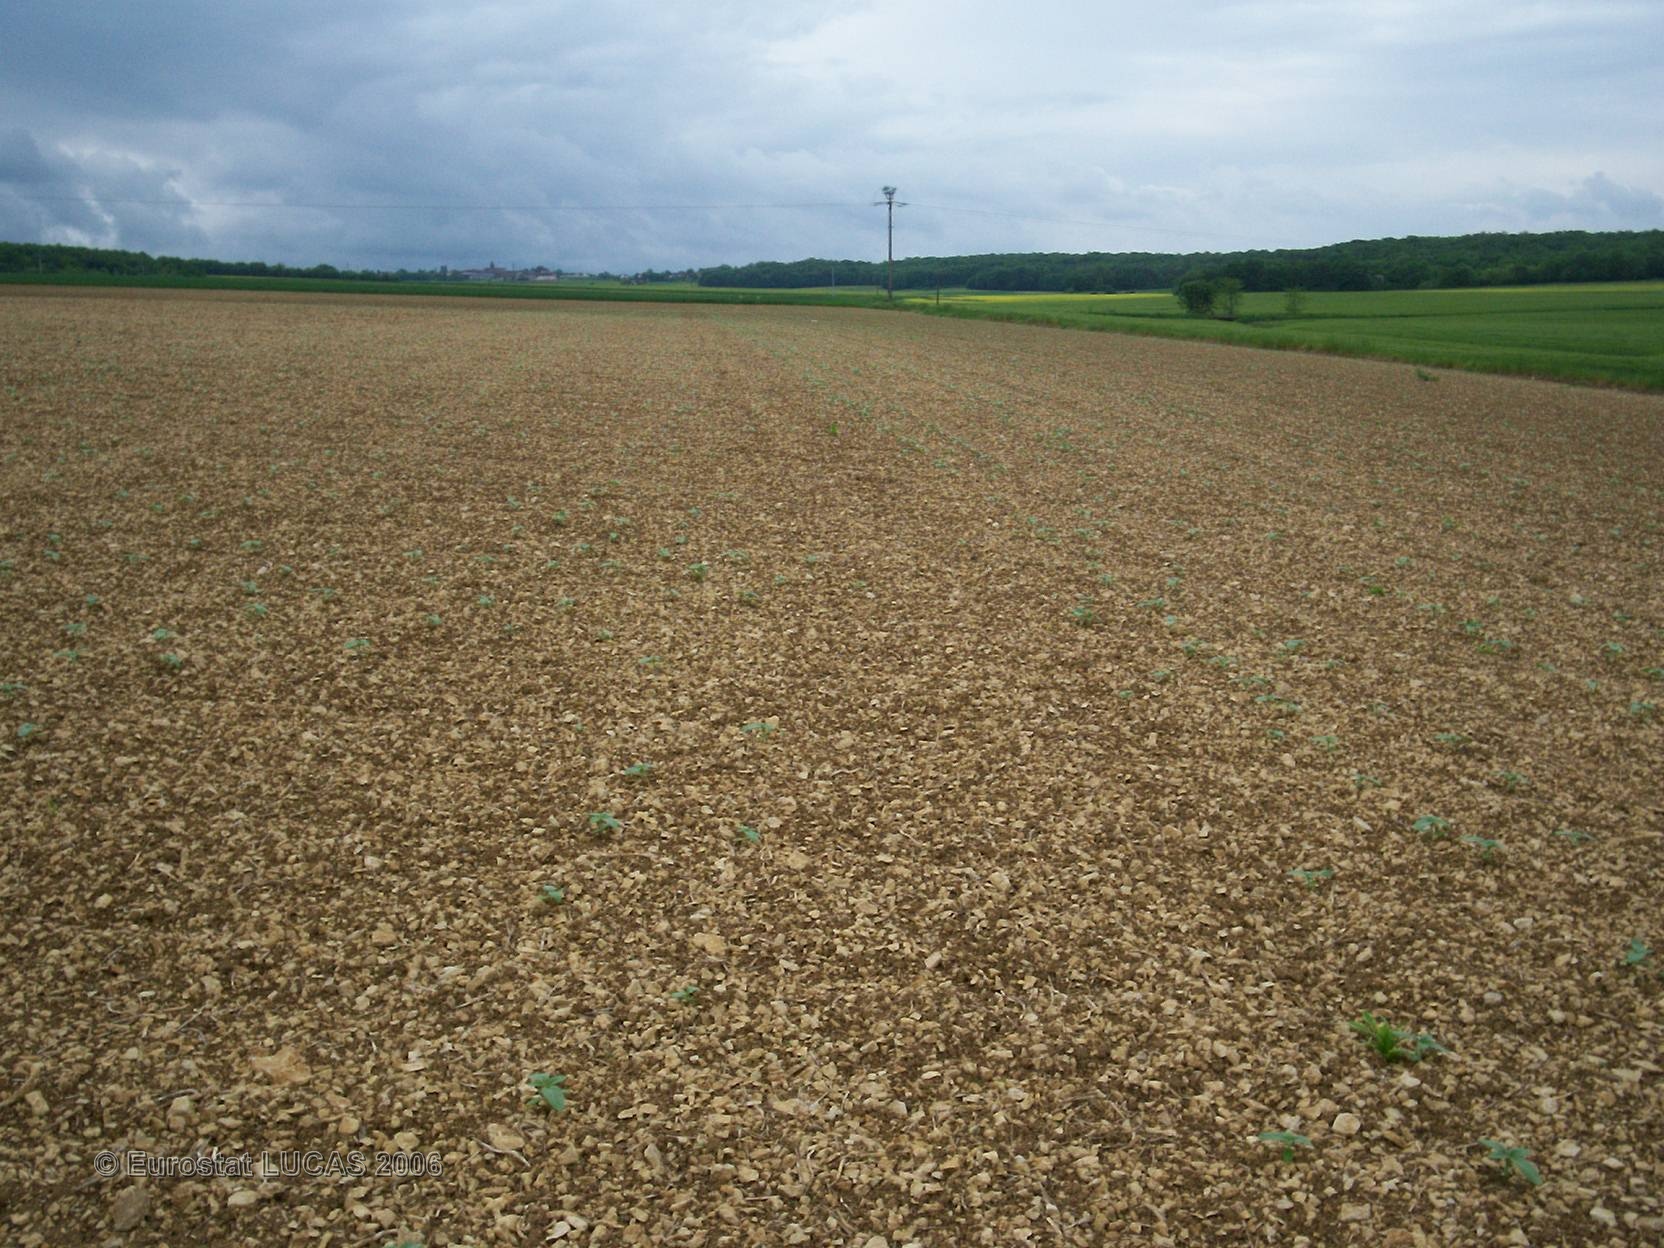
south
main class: Cropland
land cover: Sunflower
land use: Agriculture (excluding fallow land and kitchen gardens)
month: May
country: FR
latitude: 48.2109
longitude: 4.4666
